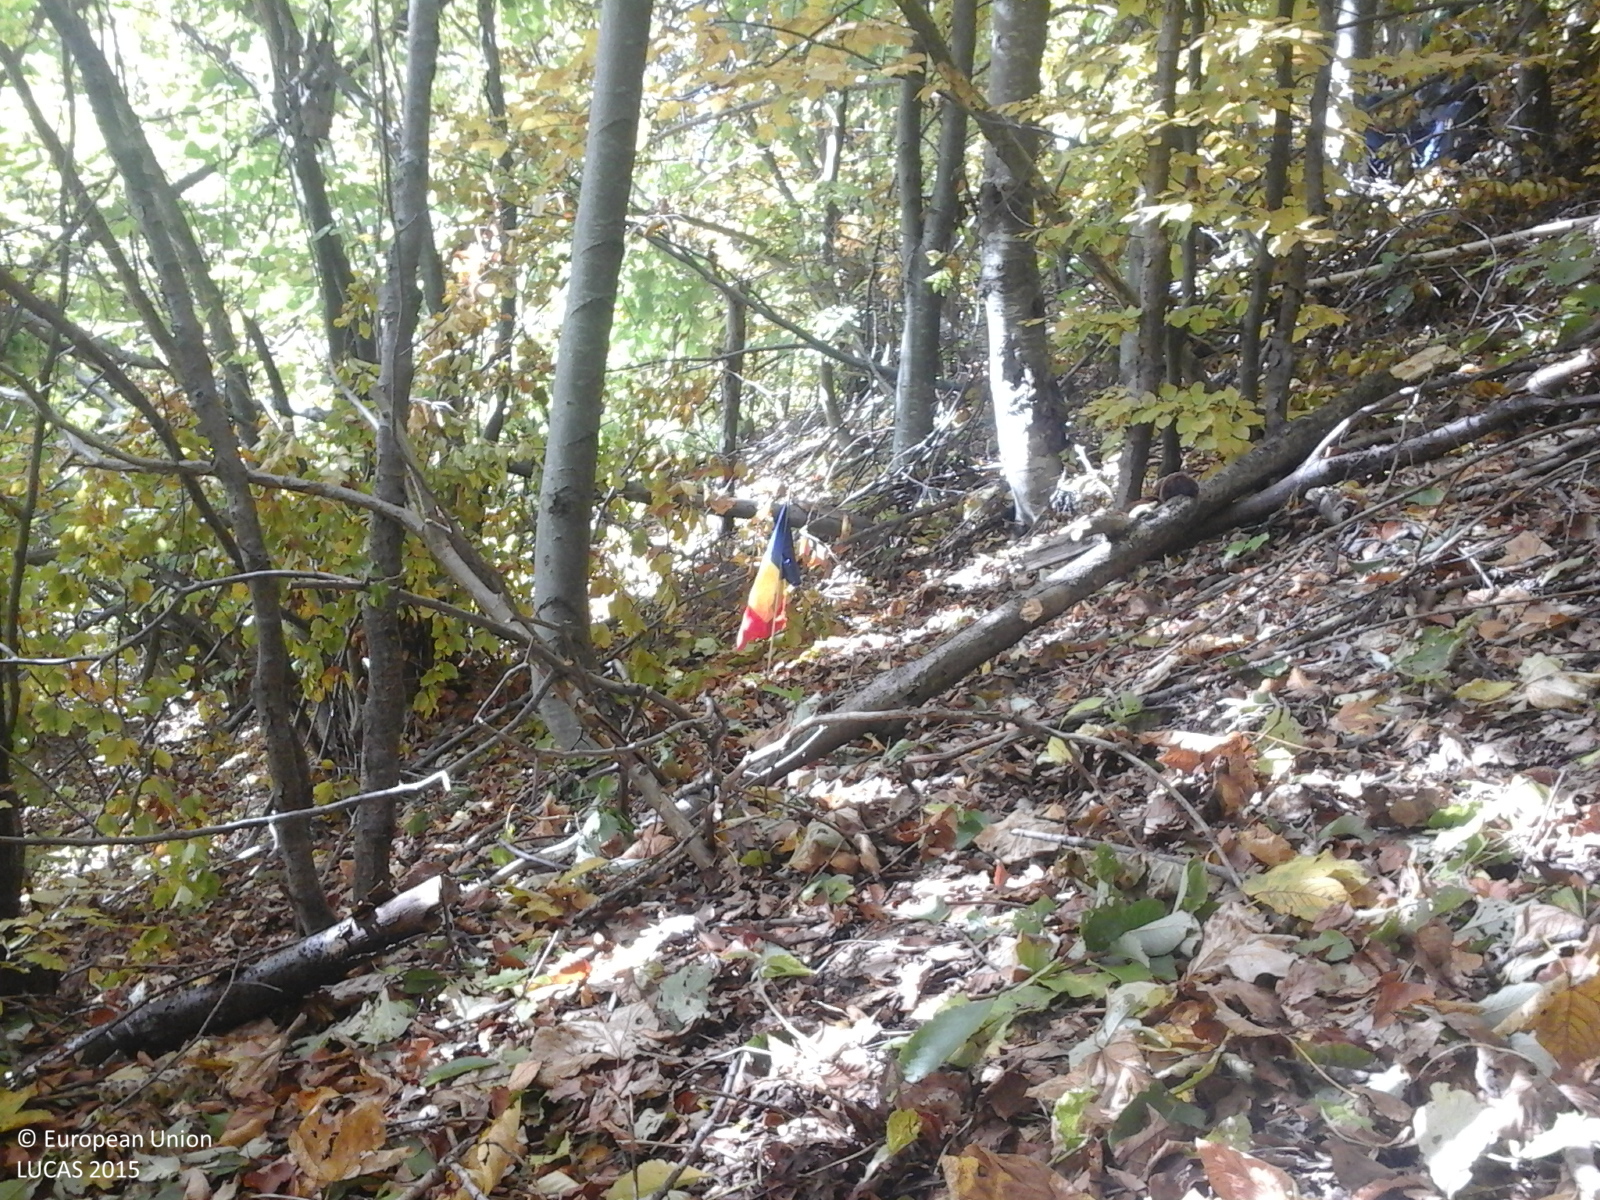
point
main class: Woodland
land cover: Broadleaved woodland
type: beech forest
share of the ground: > 75 %
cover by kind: broadleaved forest trees 100 %
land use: Forestry
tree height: > 5 m
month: October
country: RO
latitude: 45.9716
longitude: 26.5339
